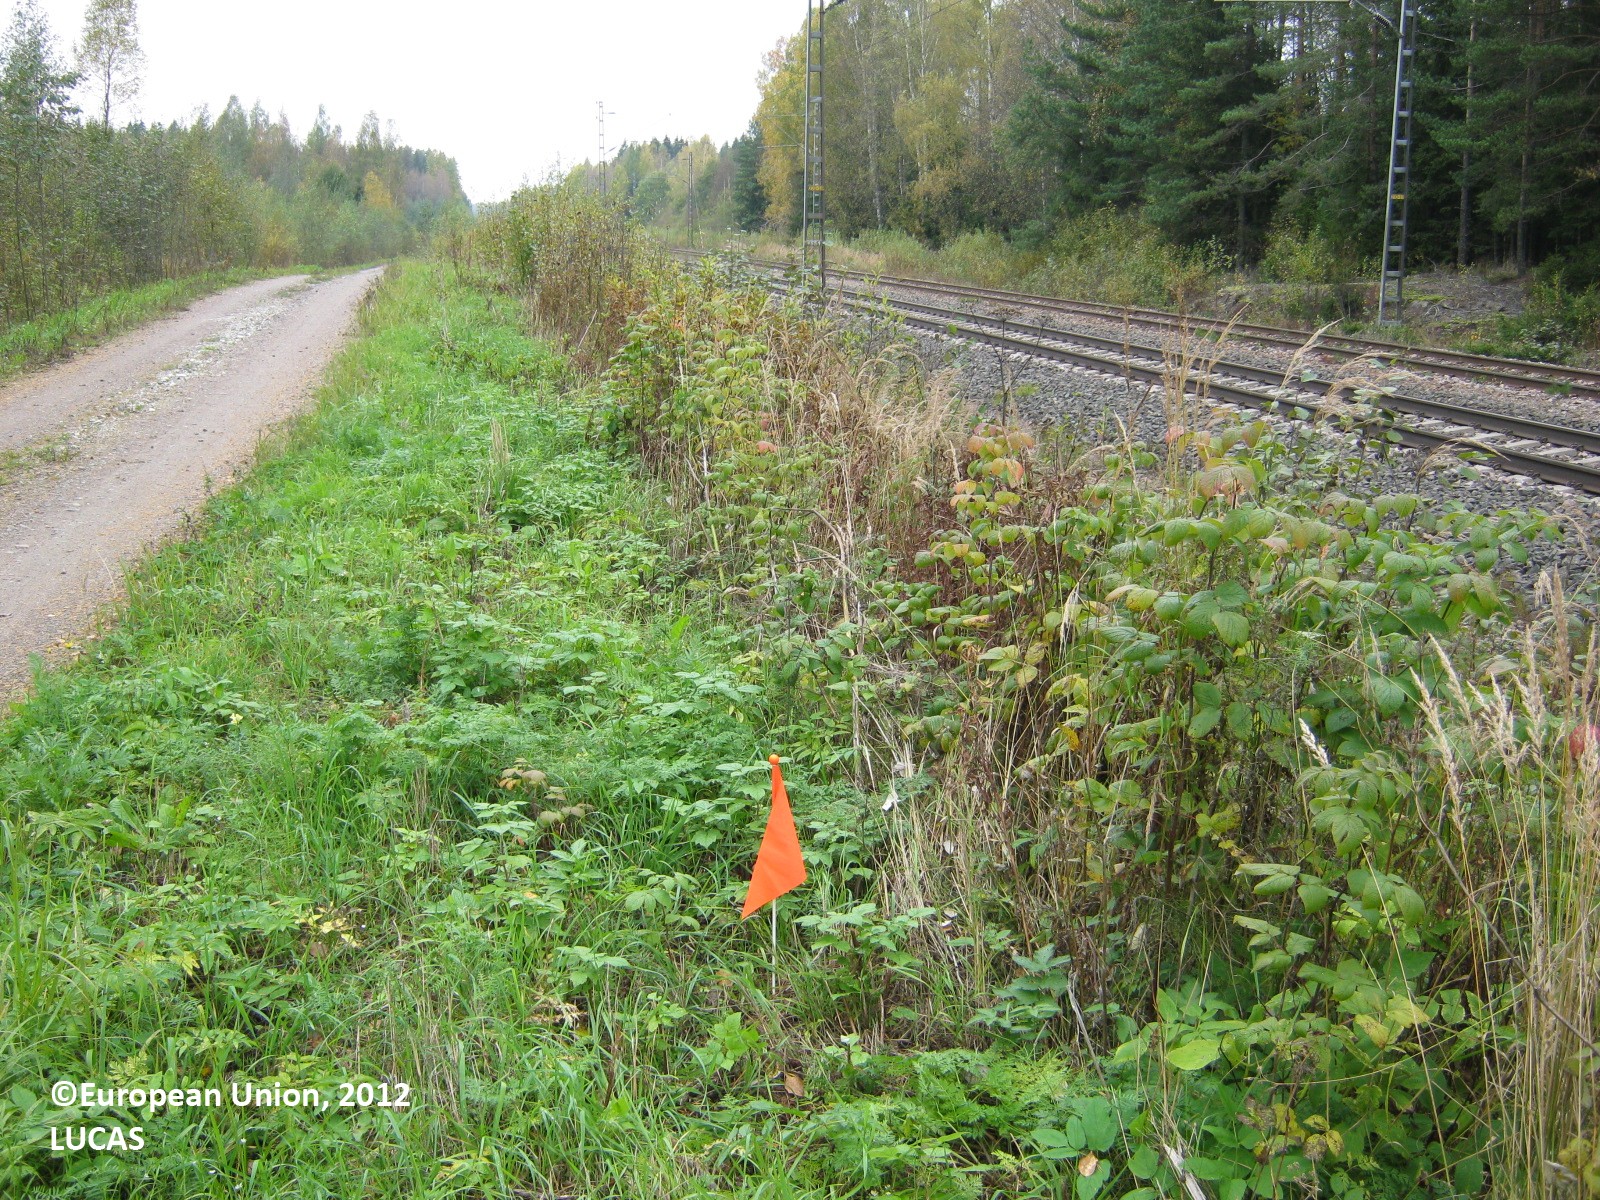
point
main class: Grassland
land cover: Spontaneously vegetated surfaces
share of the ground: > 75 %
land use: Railway transport
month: September
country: FI
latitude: 61.0175
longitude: 28.0925
